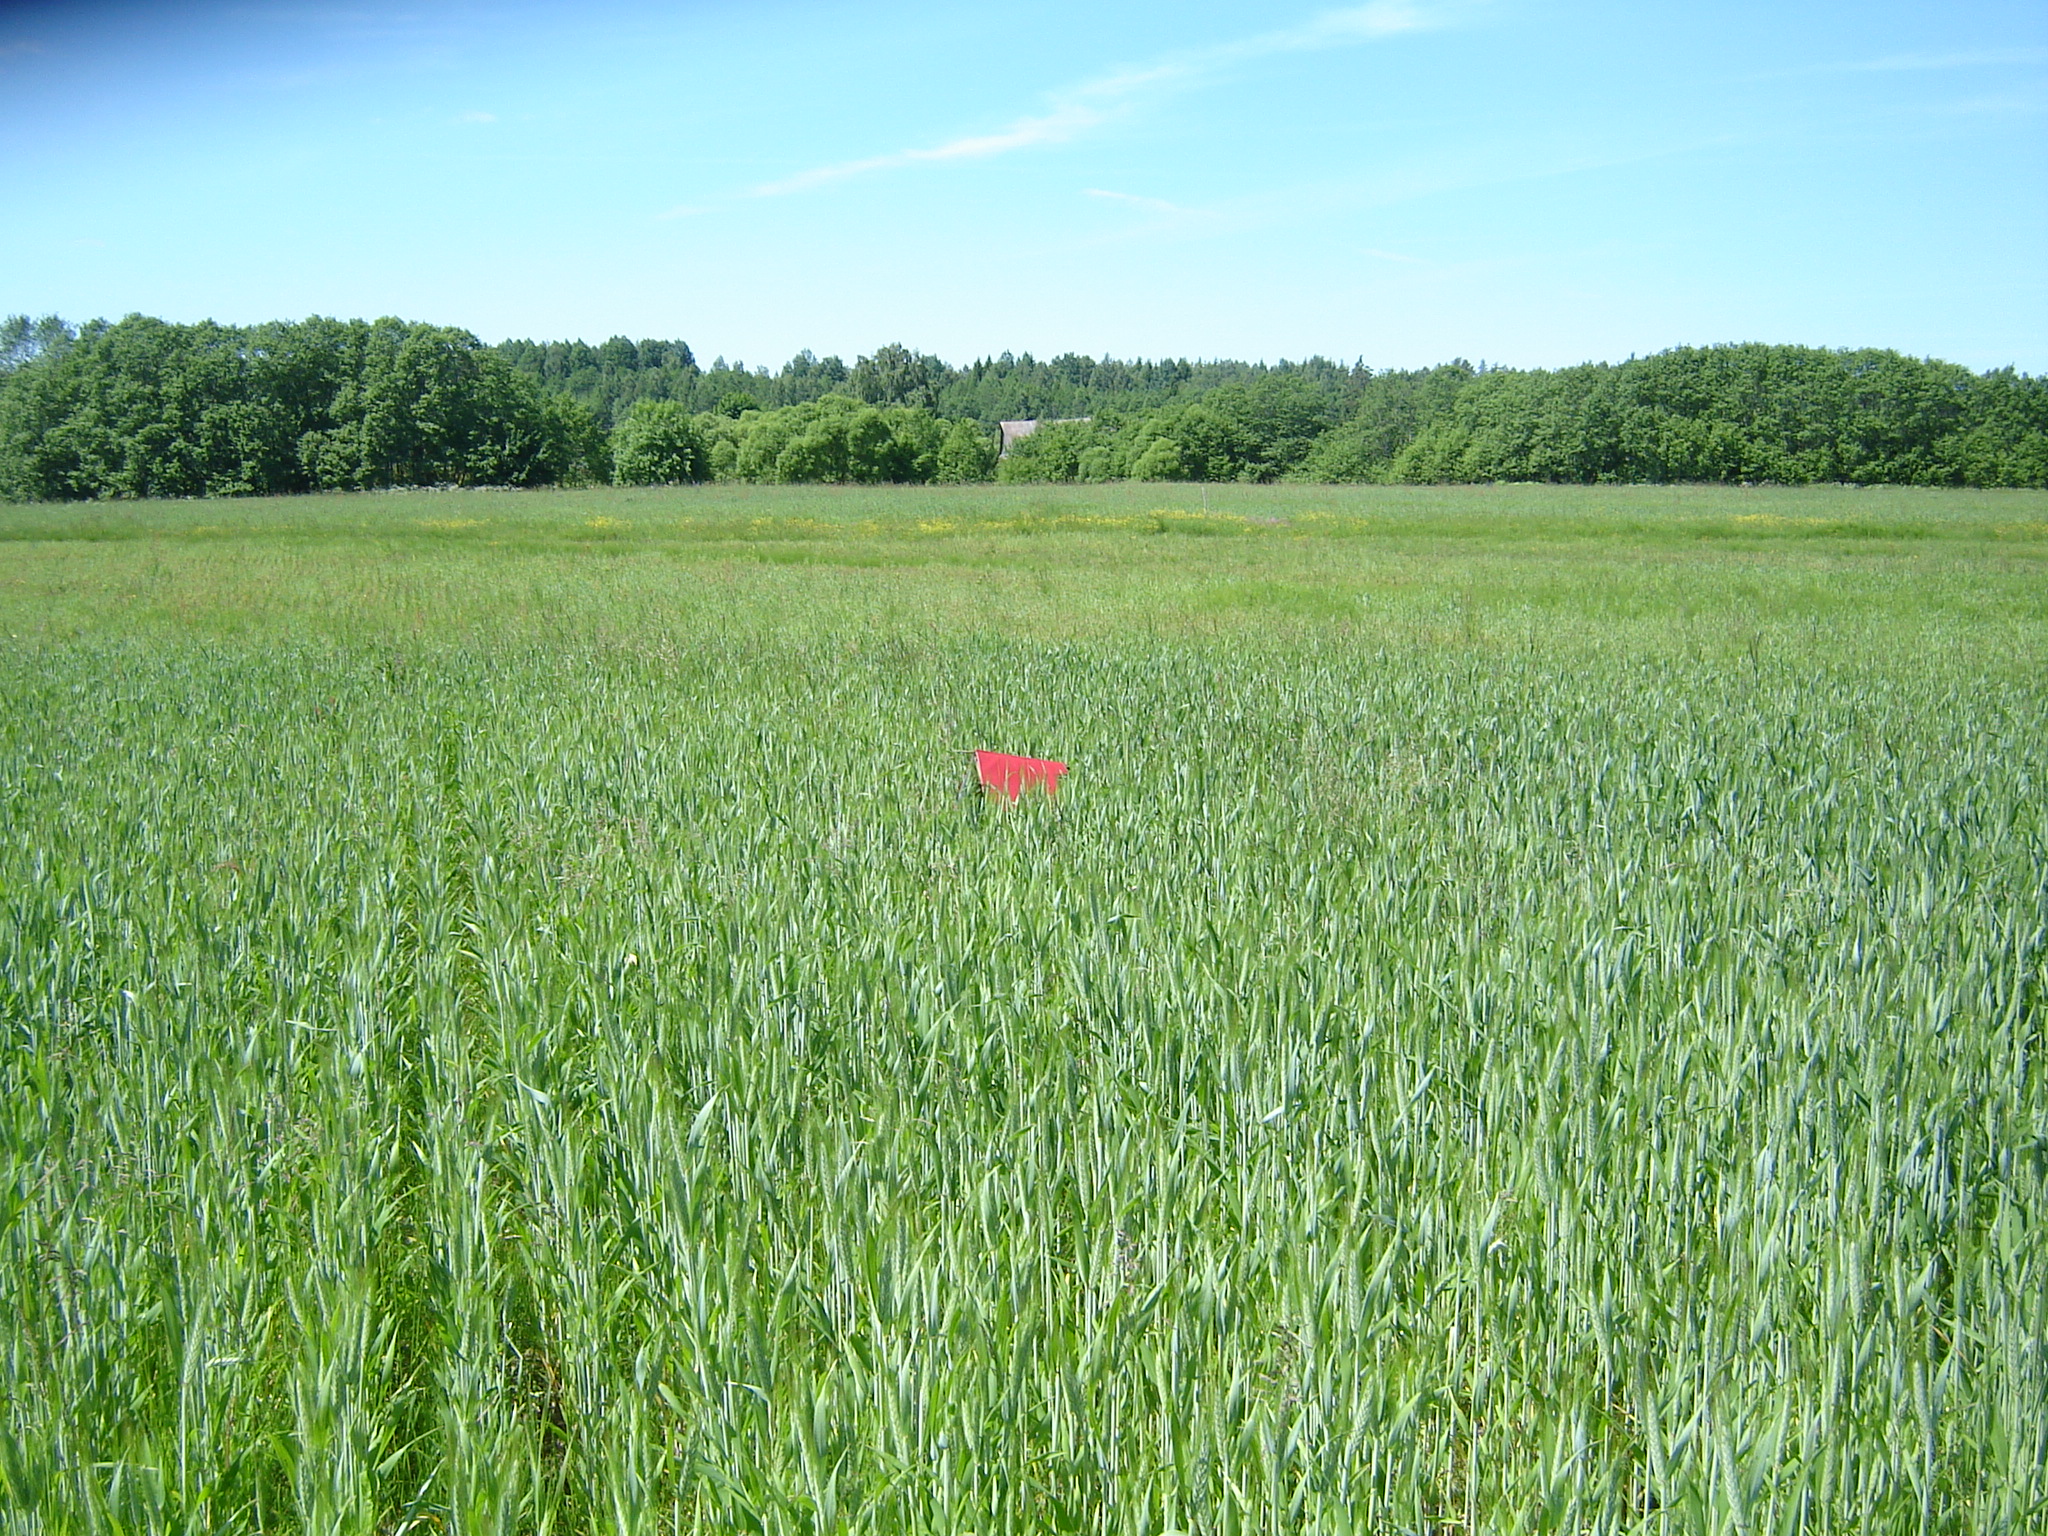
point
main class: Cropland
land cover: Rye
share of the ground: > 75 %
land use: Agriculture (excluding fallow land and kitchen gardens)
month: June
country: LT
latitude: 55.6745
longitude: 25.0760
